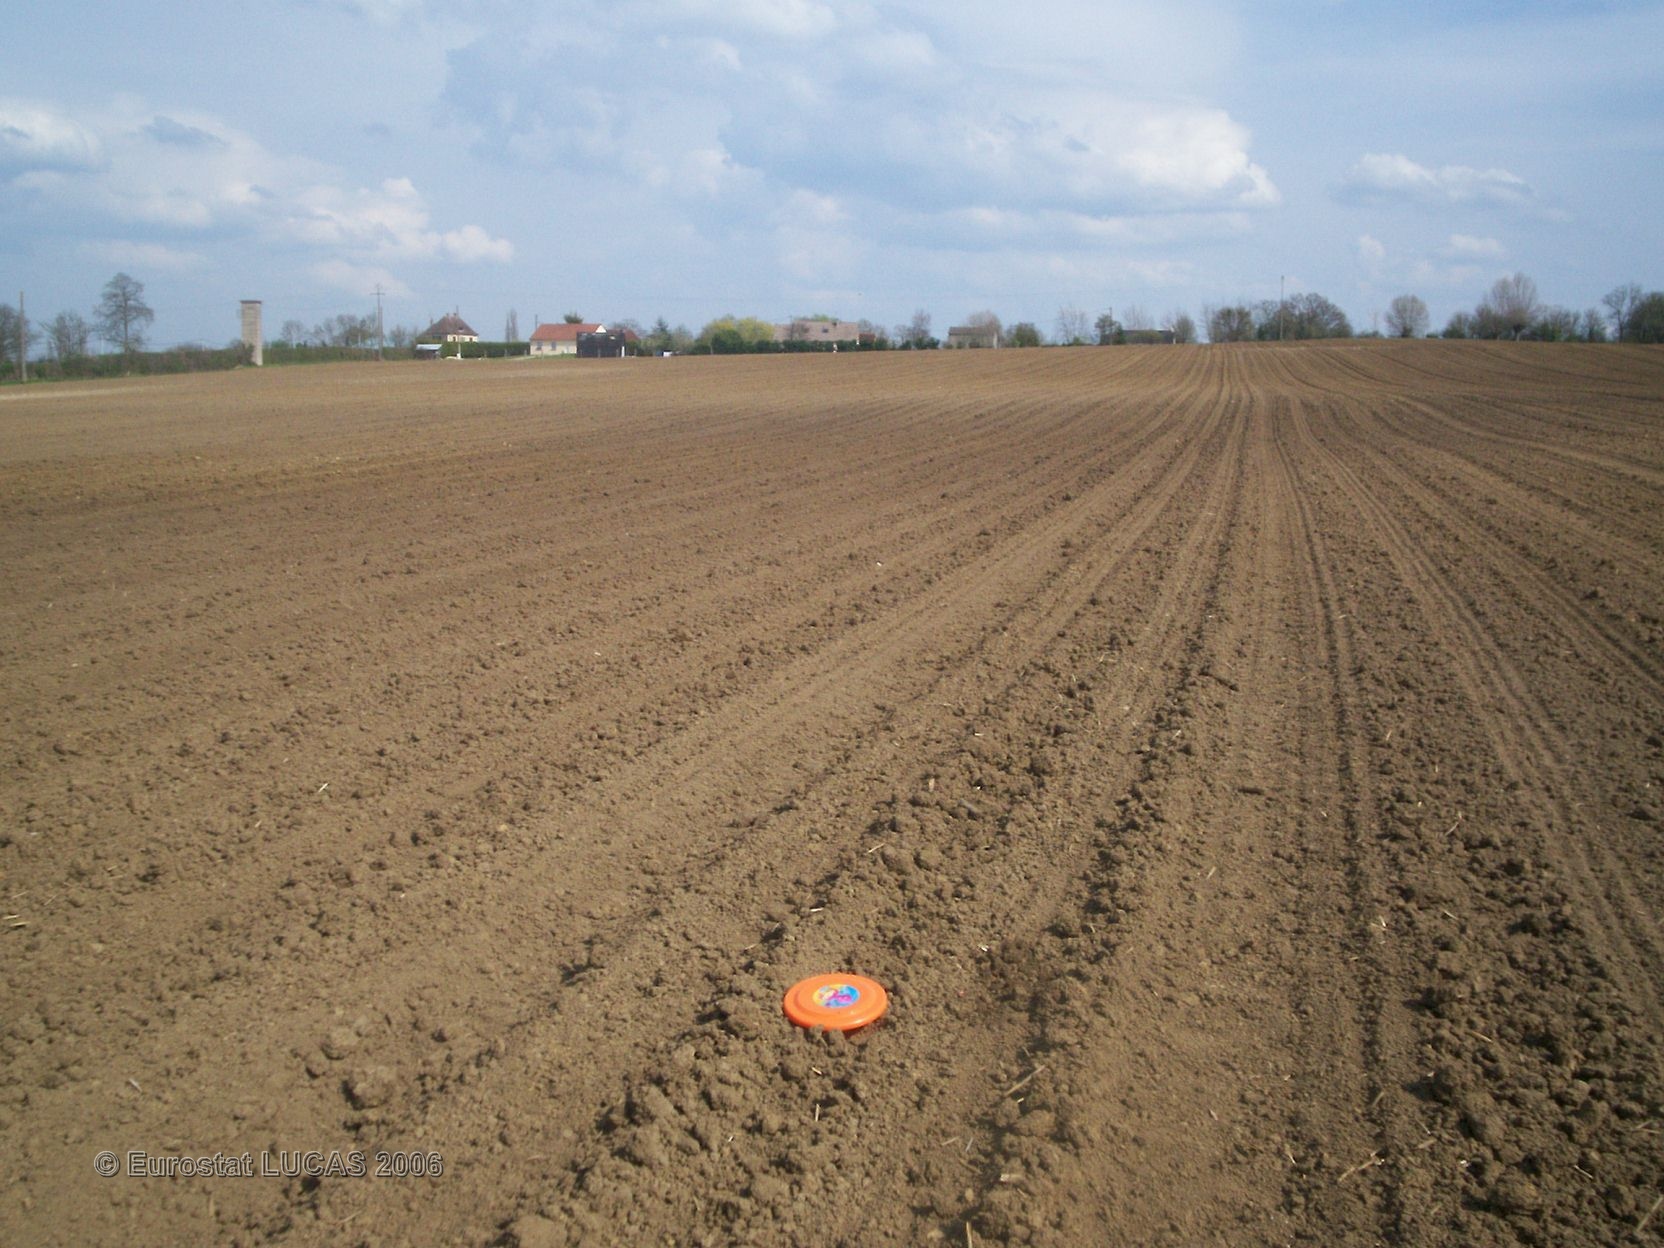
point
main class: Cropland
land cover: Maize
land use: Agriculture (excluding fallow land and kitchen gardens)
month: April
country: FR
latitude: 48.7743
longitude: 0.1055
